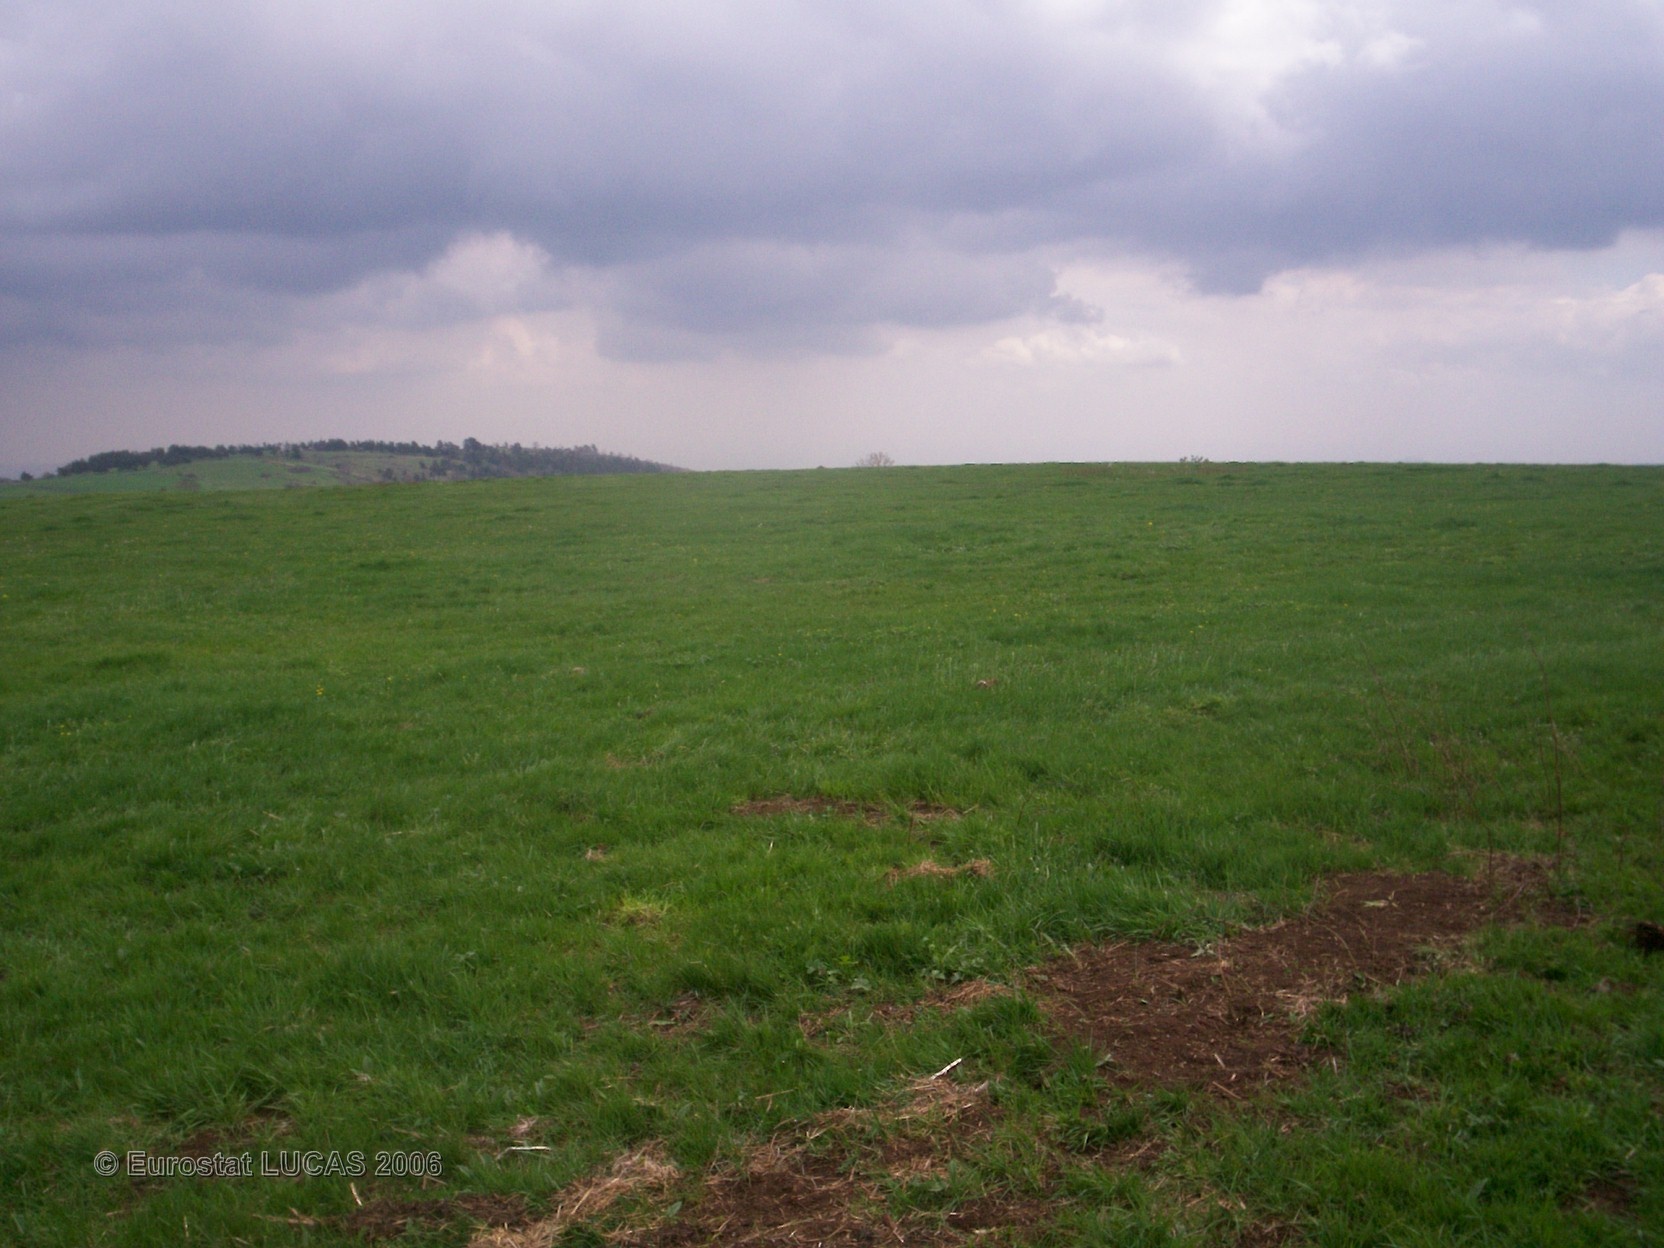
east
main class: Grassland
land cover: Grassland without tree/shrub cover
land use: Agriculture (excluding fallow land and kitchen gardens)
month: April
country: FR
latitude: 45.6129
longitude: 2.9598
